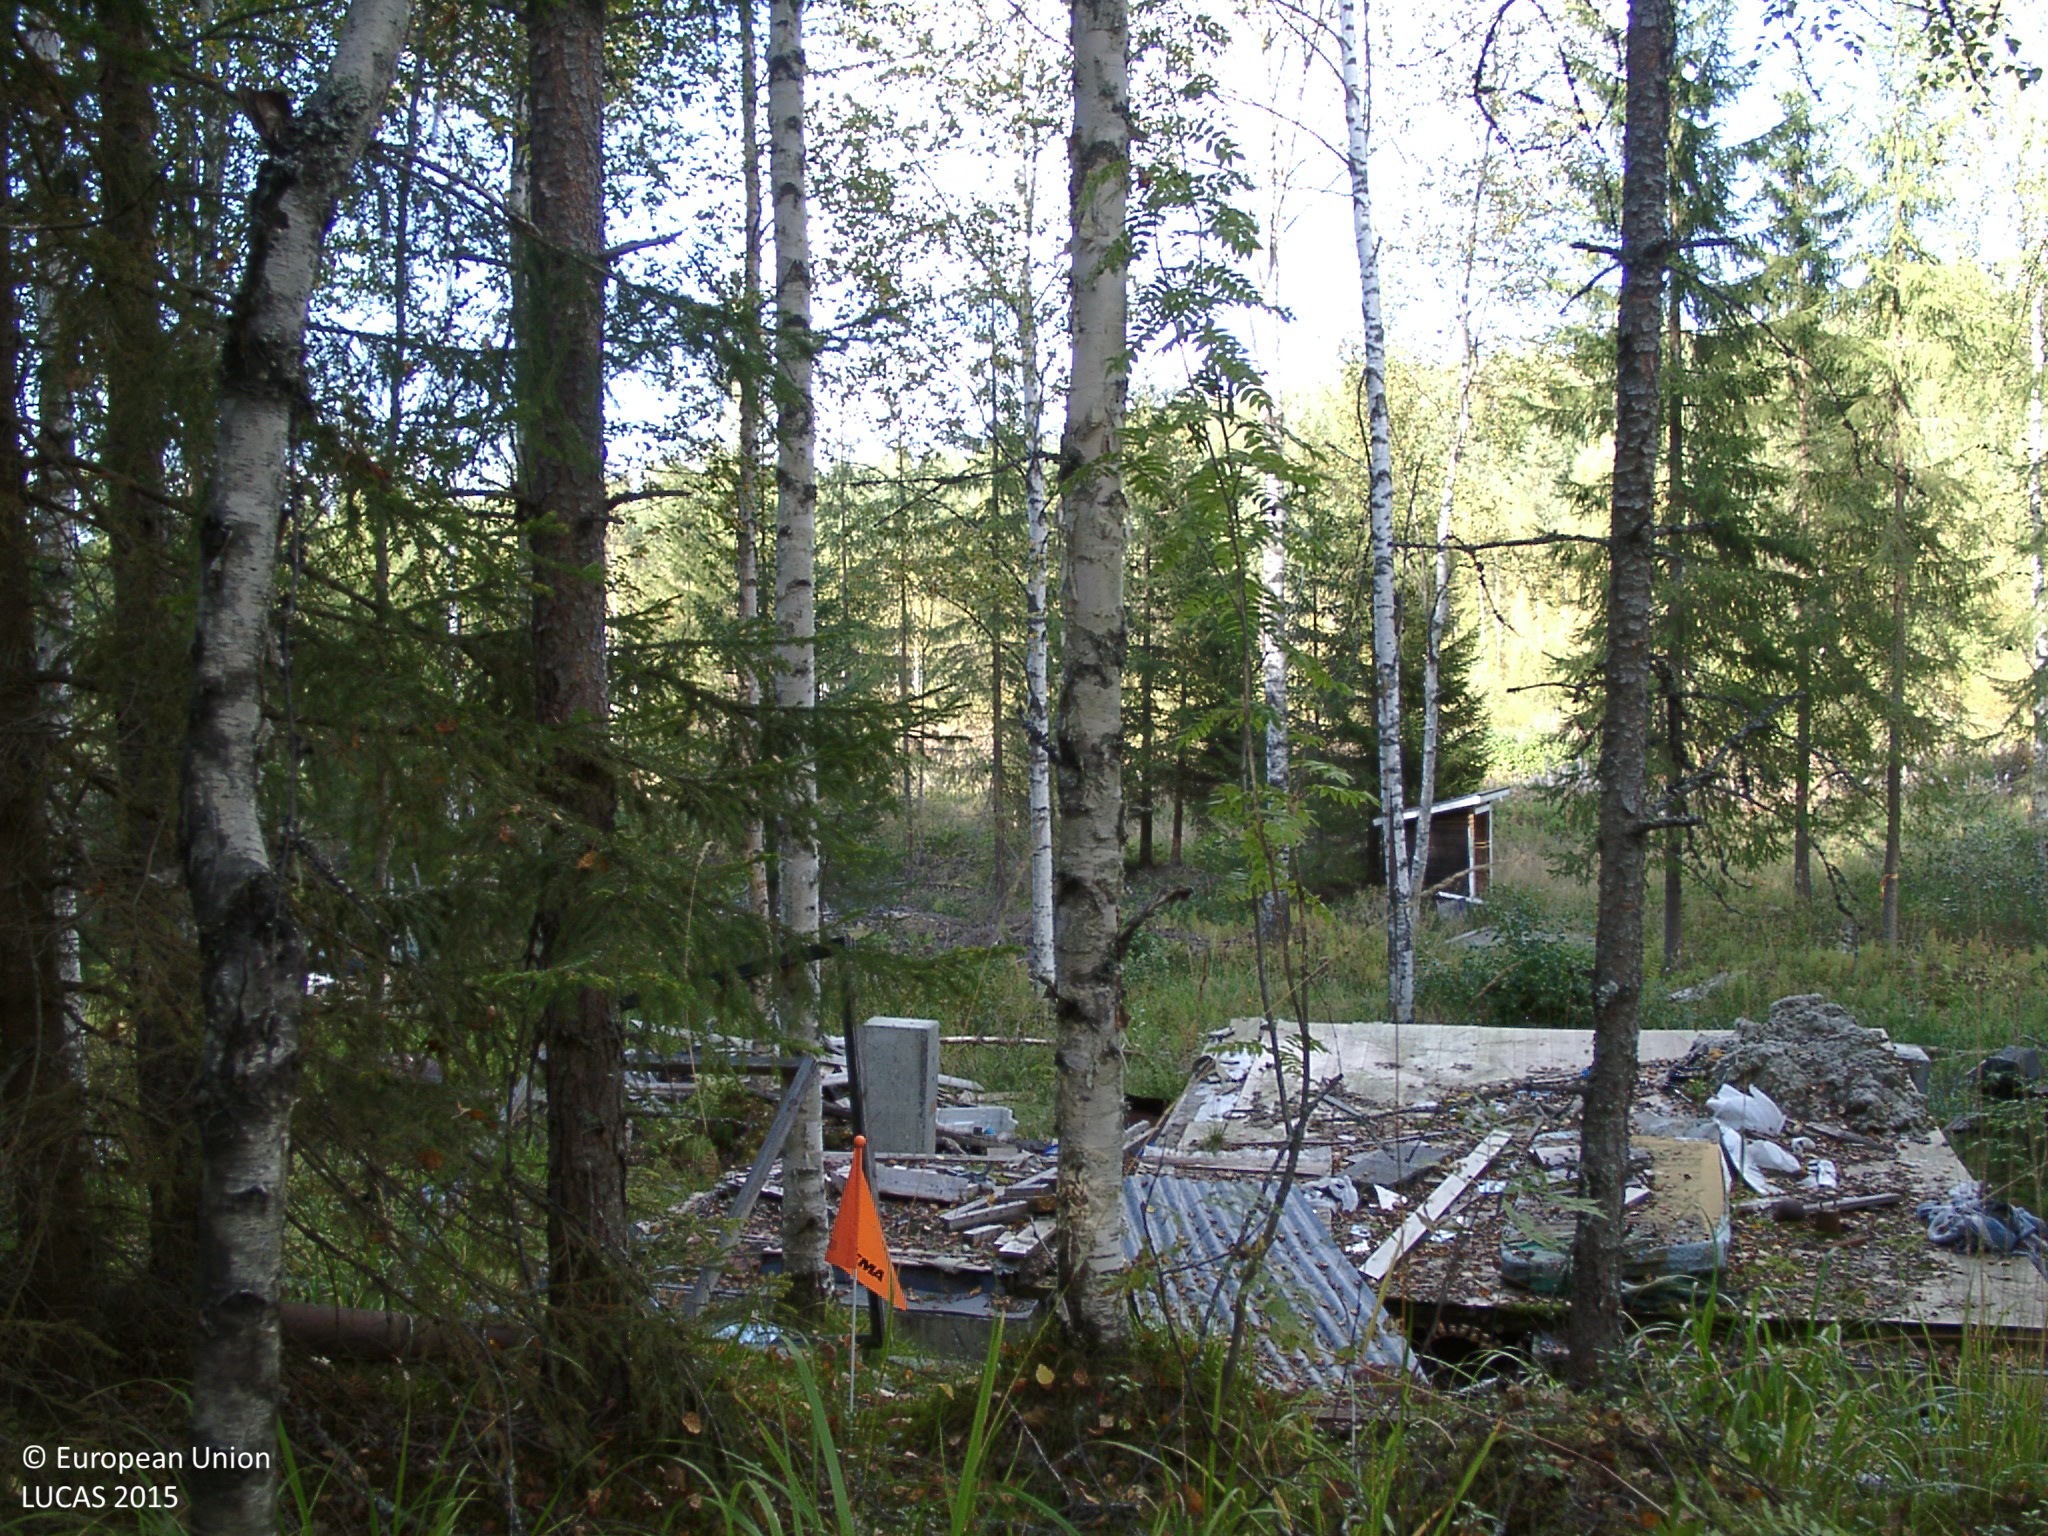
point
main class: Woodland
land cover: Pine dominated mixed woodland
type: boreal forest
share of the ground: 50 - 75 %
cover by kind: coniferous forest trees 30 %, broadleaved forest trees 30 %, herbaceous plants 25 %, lichens and mosses 10 %
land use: Forestry
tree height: > 5 m
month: September
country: FI
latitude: 62.5256
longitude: 25.6388
